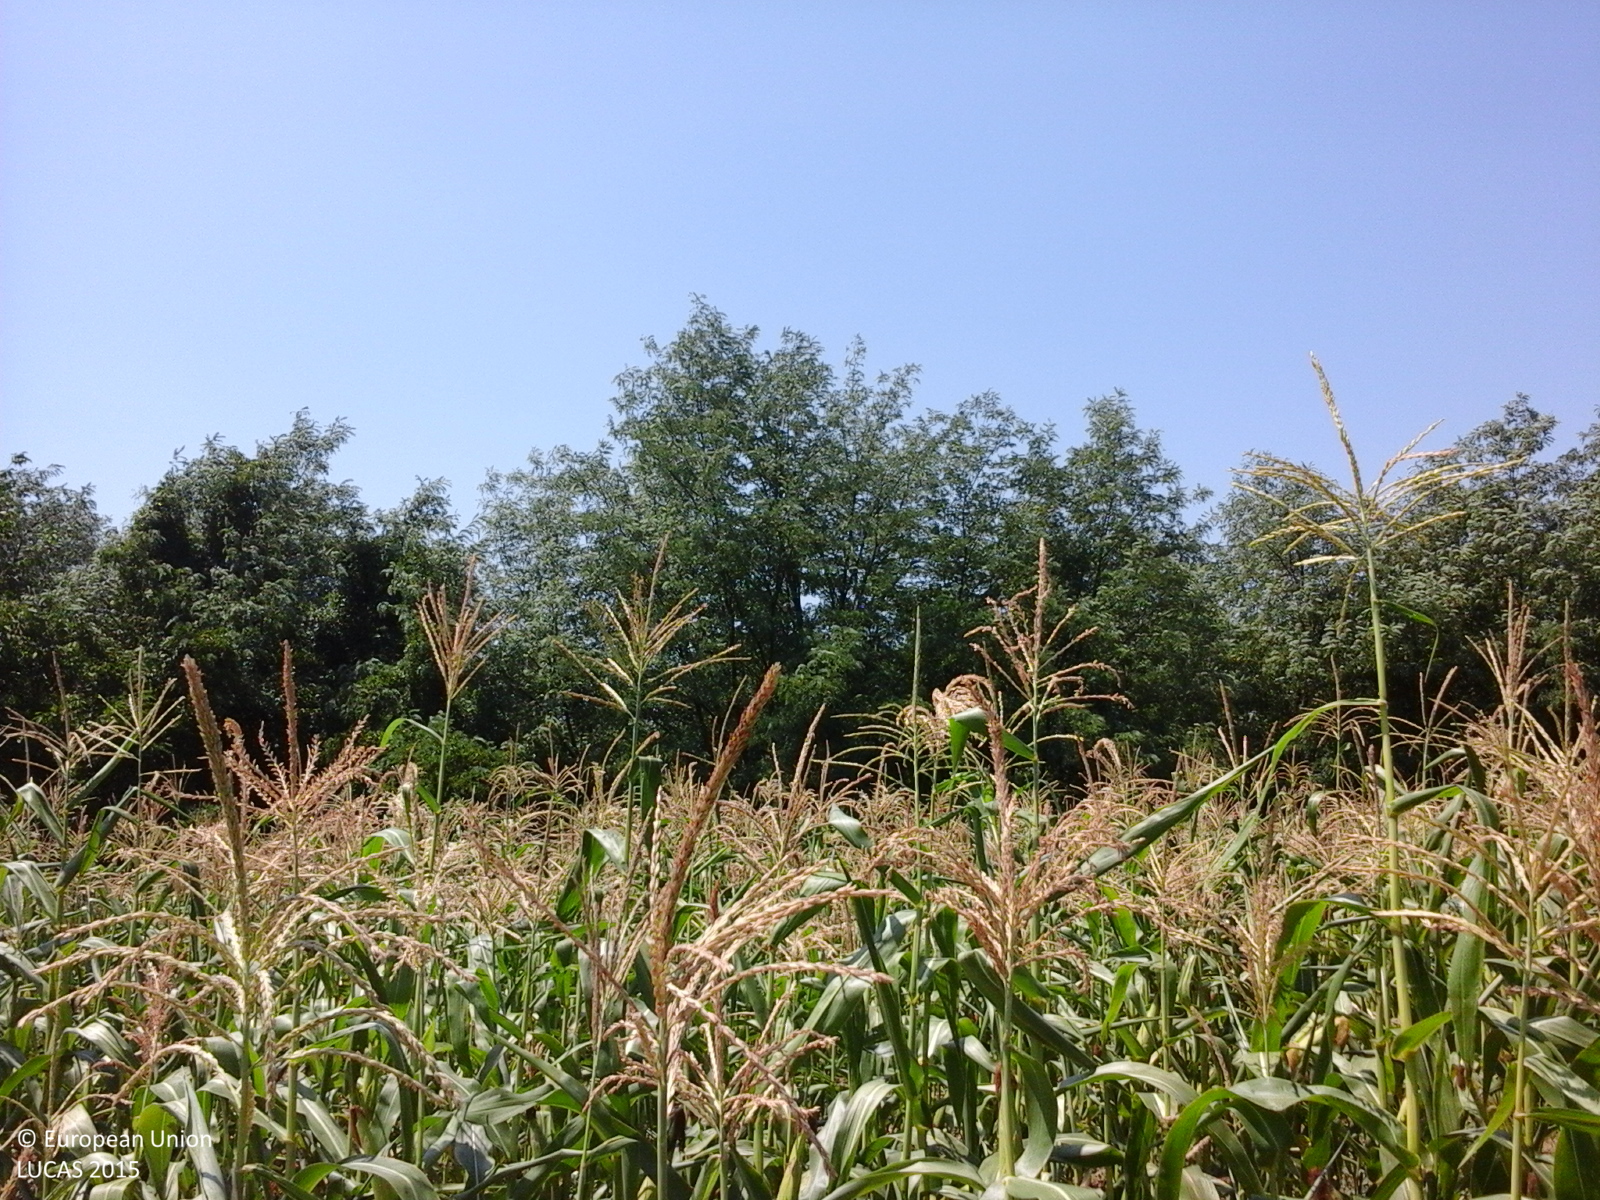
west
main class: Cropland
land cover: Maize
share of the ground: > 75 %
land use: Agriculture (excluding fallow land and kitchen gardens)
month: July
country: RO
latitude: 46.2585
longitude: 27.2650
